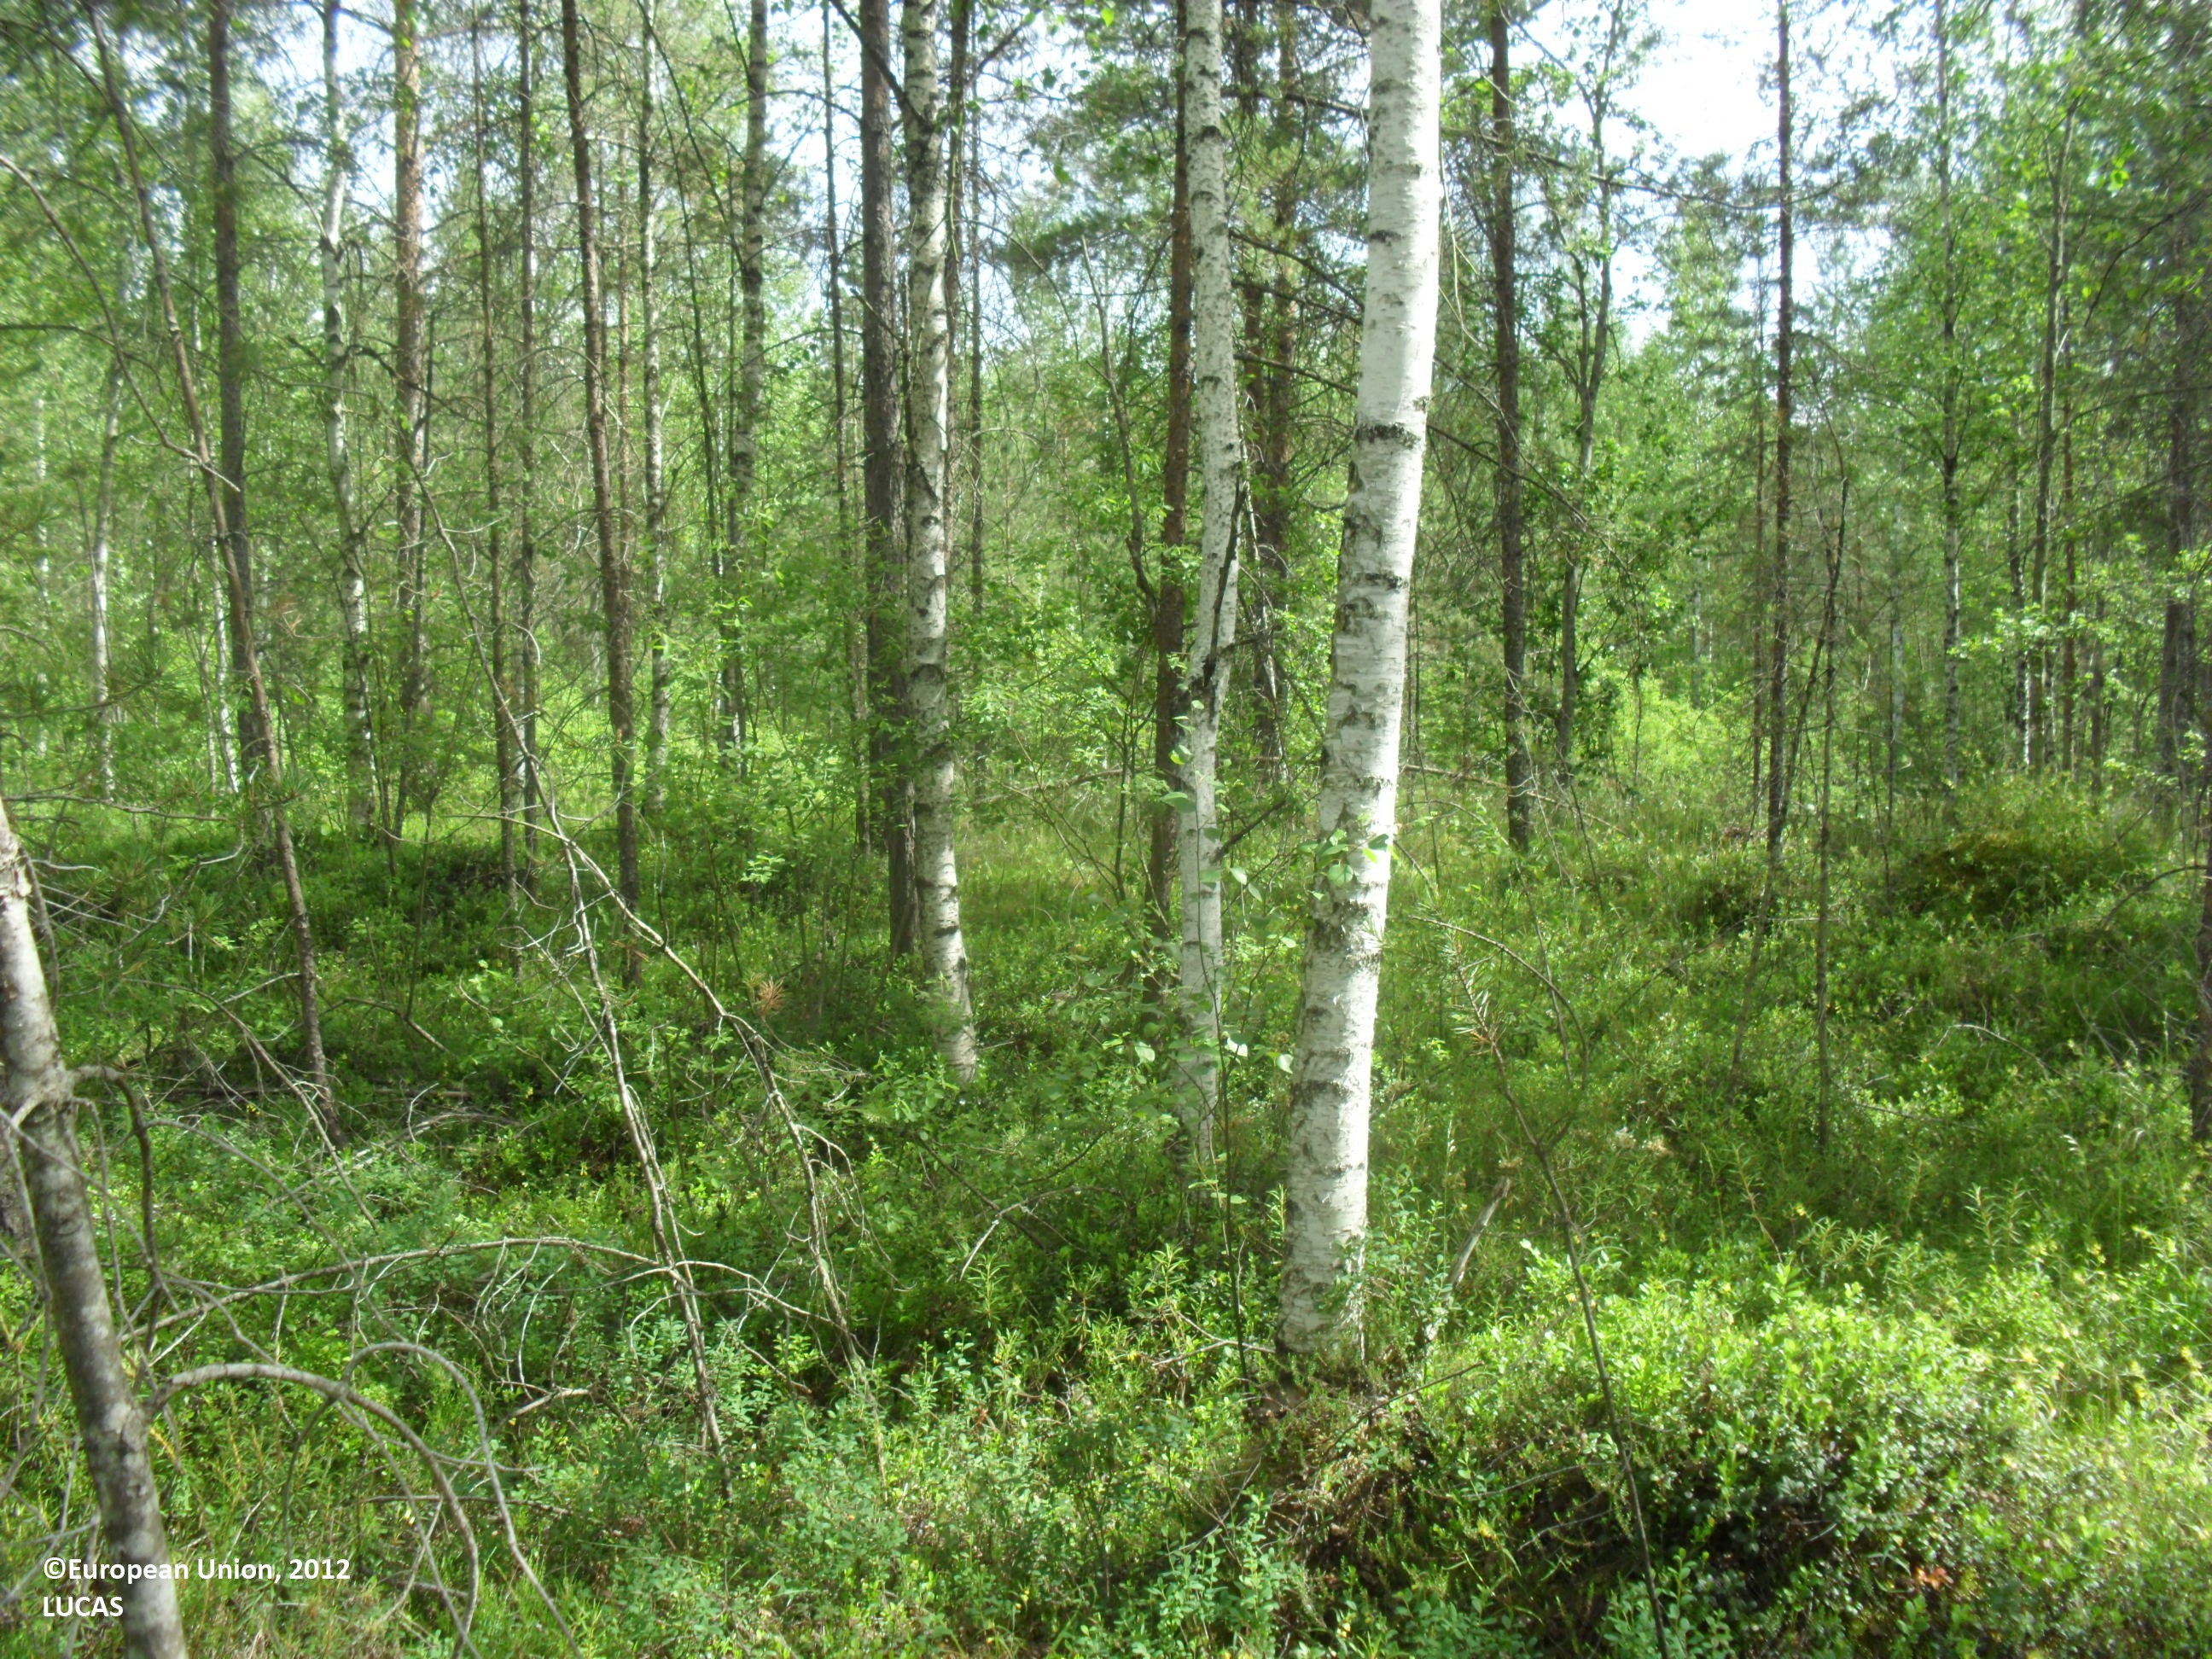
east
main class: Woodland
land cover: Other mixed woodland
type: boreal forest
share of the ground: 50 - 75 %
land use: Forestry
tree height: > 5 m
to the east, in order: Other mixed woodland; Ditches and canals; Oats
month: July
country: FI
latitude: 63.5797
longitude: 23.9069
